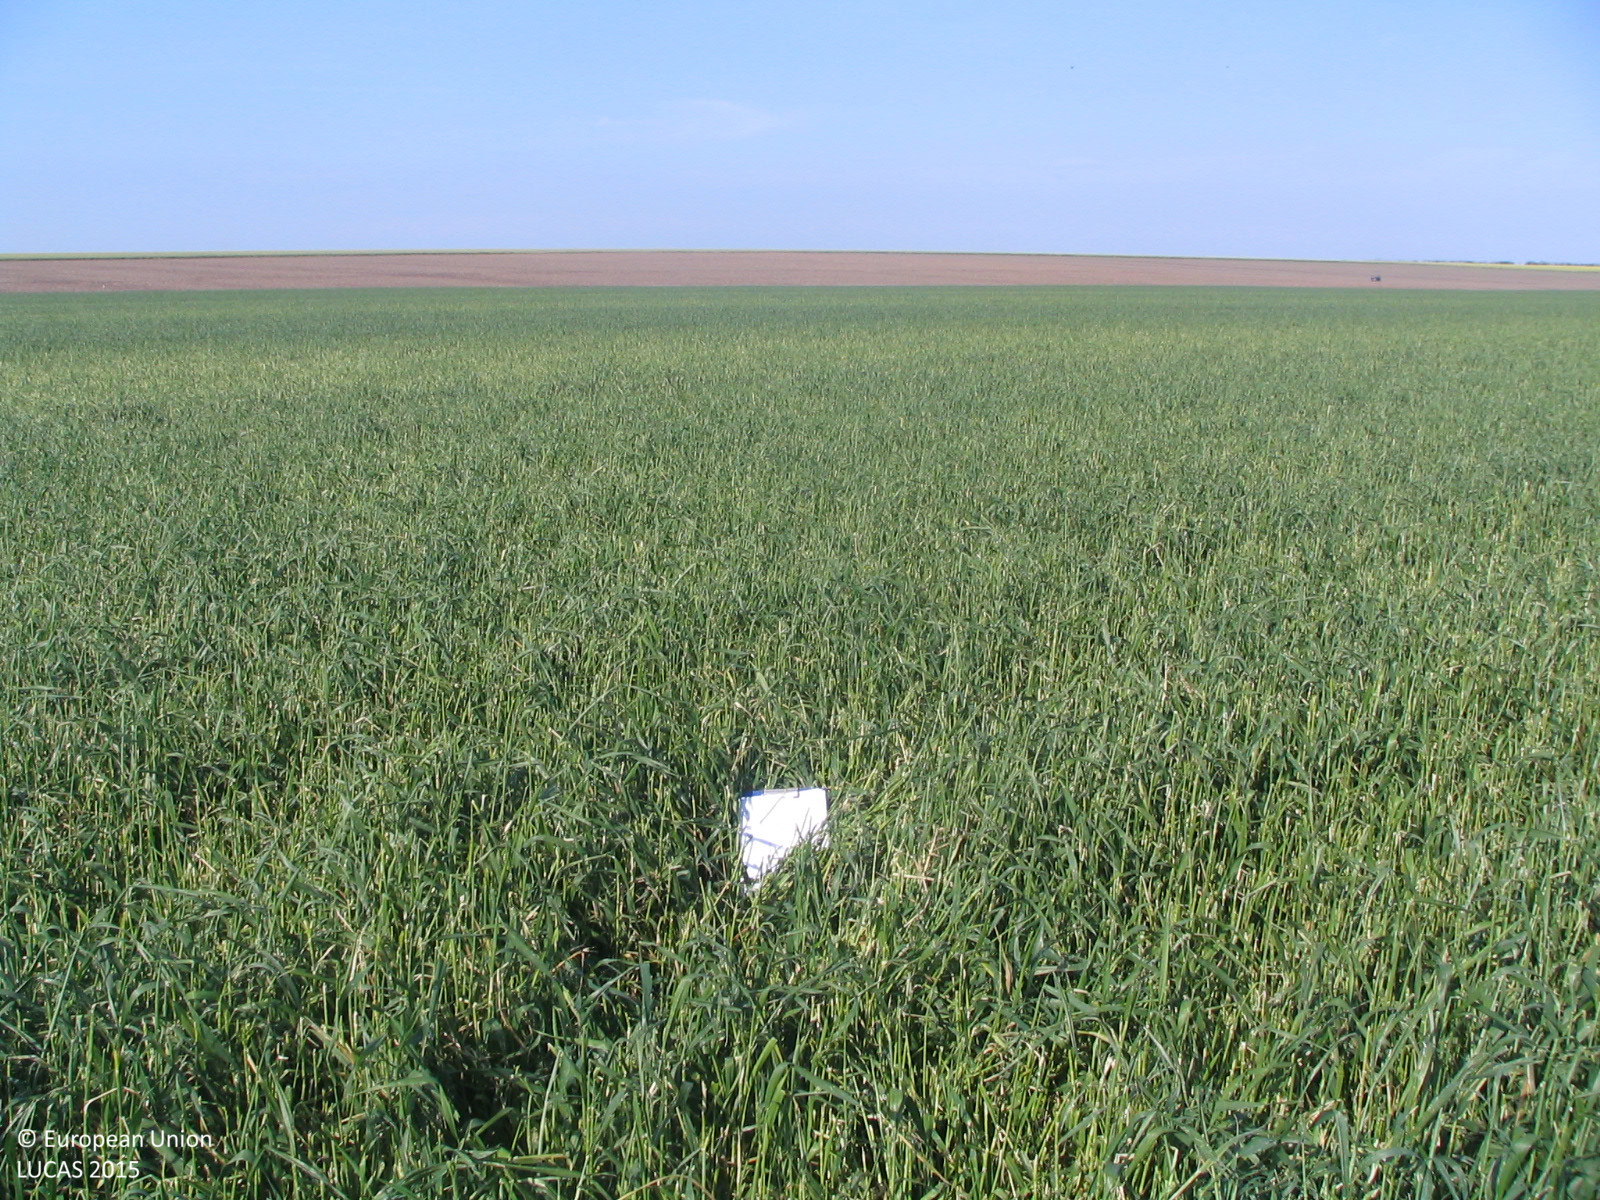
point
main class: Cropland
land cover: Common wheat
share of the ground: > 75 %
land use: Agriculture (excluding fallow land and kitchen gardens)
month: May
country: BG
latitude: 43.5632
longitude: 23.9810
